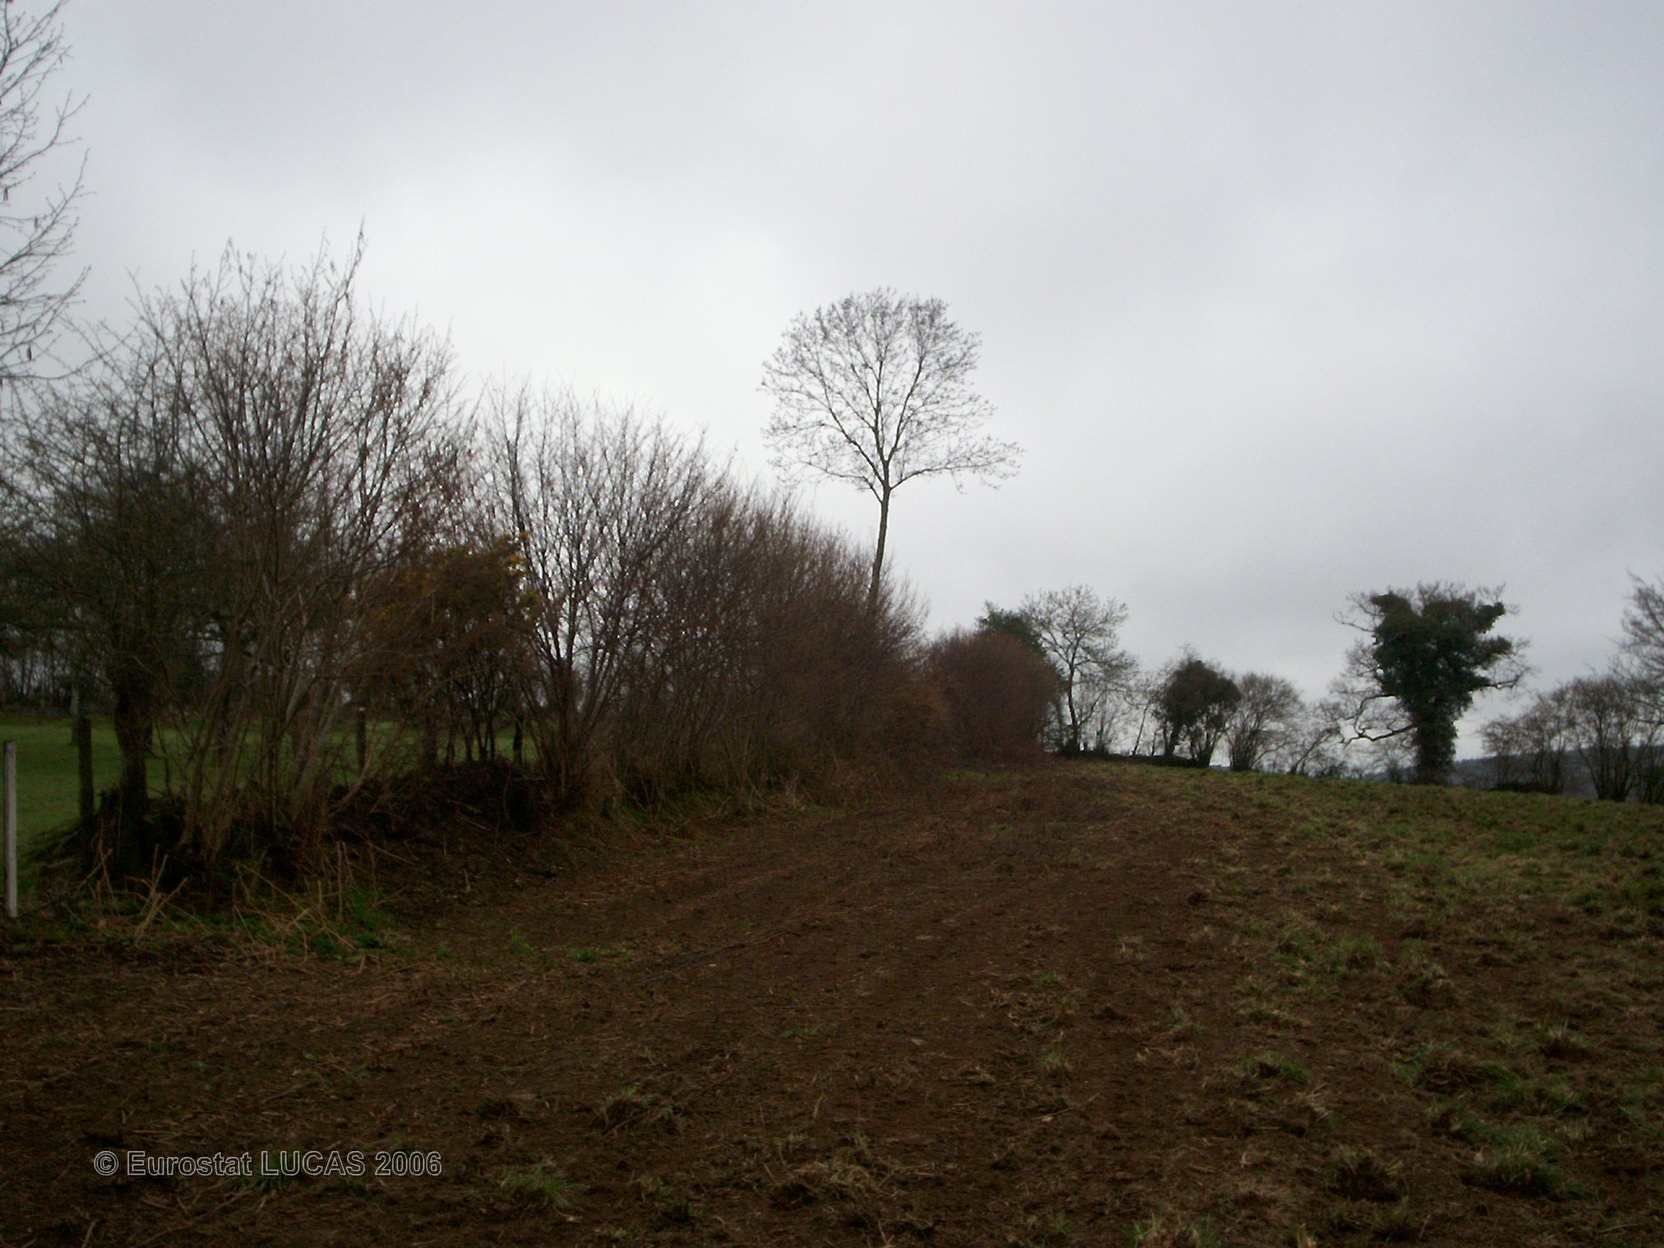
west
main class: Grassland
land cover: Grassland without tree/shrub cover
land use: Agriculture (excluding fallow land and kitchen gardens)
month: May
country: FR
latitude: 49.5187
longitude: -1.5847
